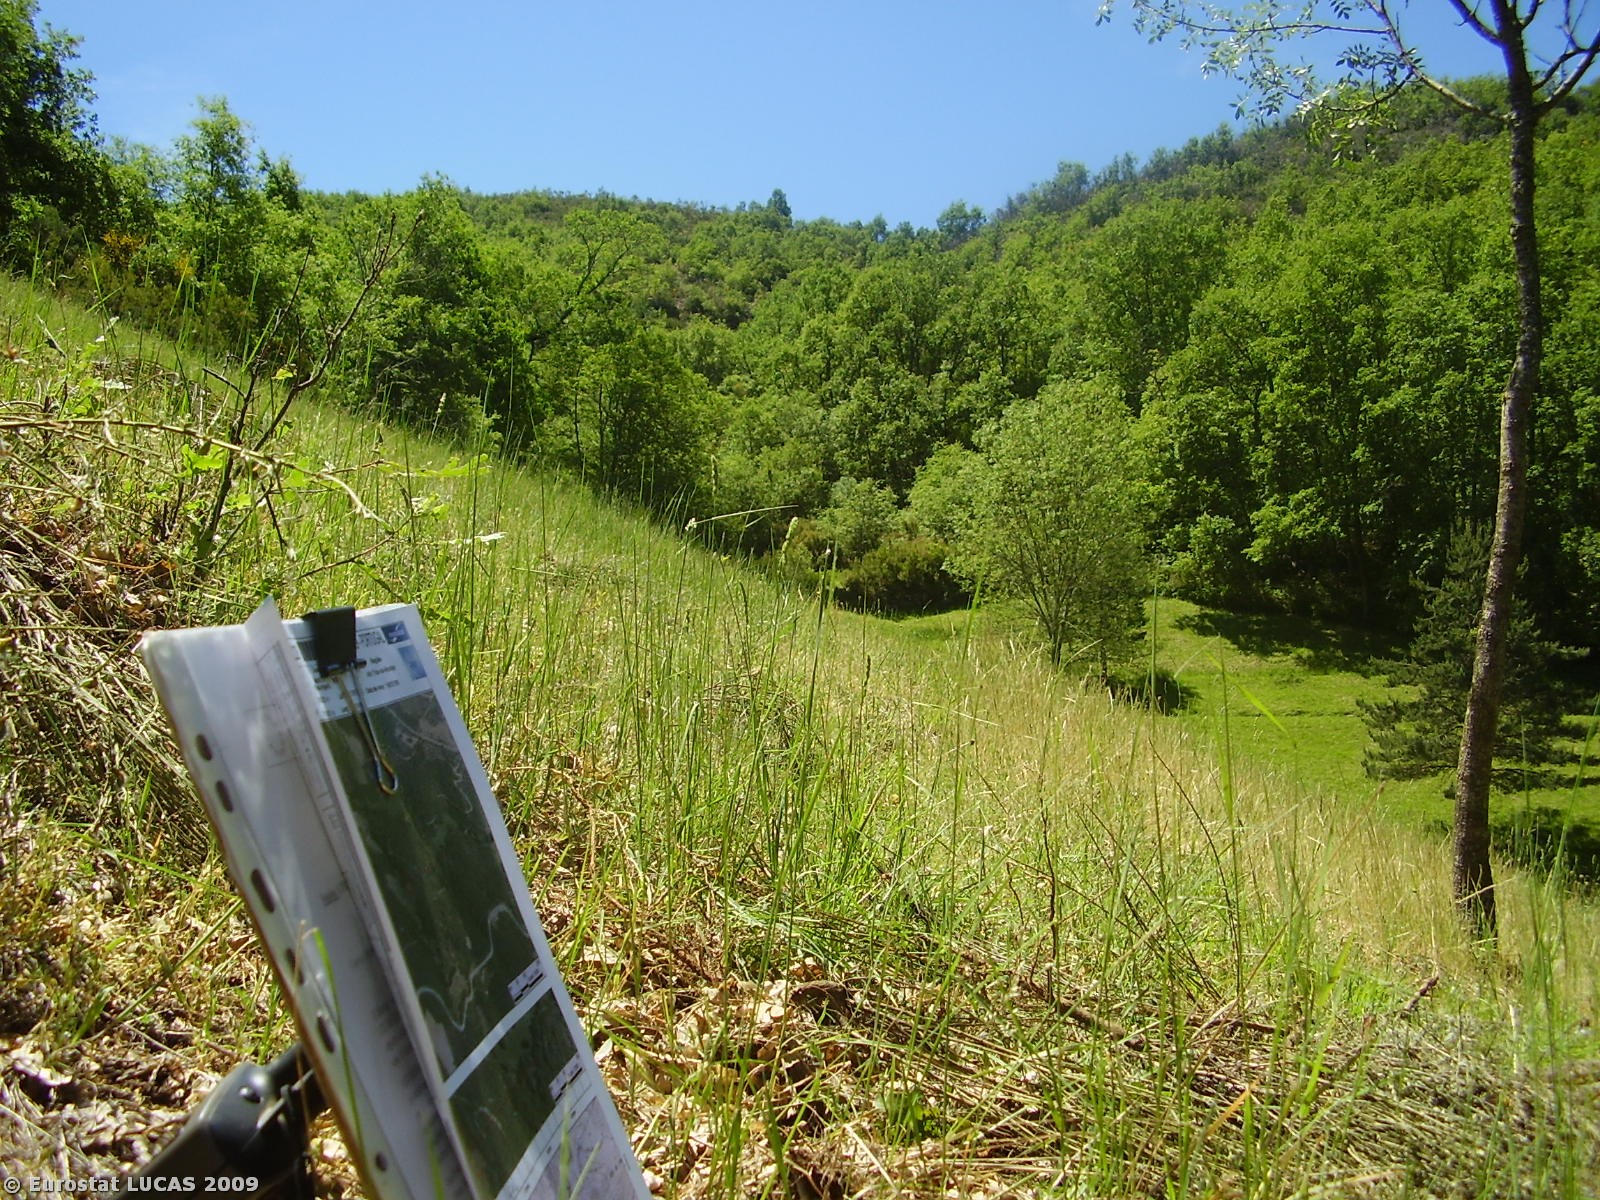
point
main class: Grassland
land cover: Grassland without tree/shrub cover
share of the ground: > 75 %
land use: Agriculture (excluding fallow land and kitchen gardens)
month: June
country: PT
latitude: 41.7177
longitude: -6.9072
